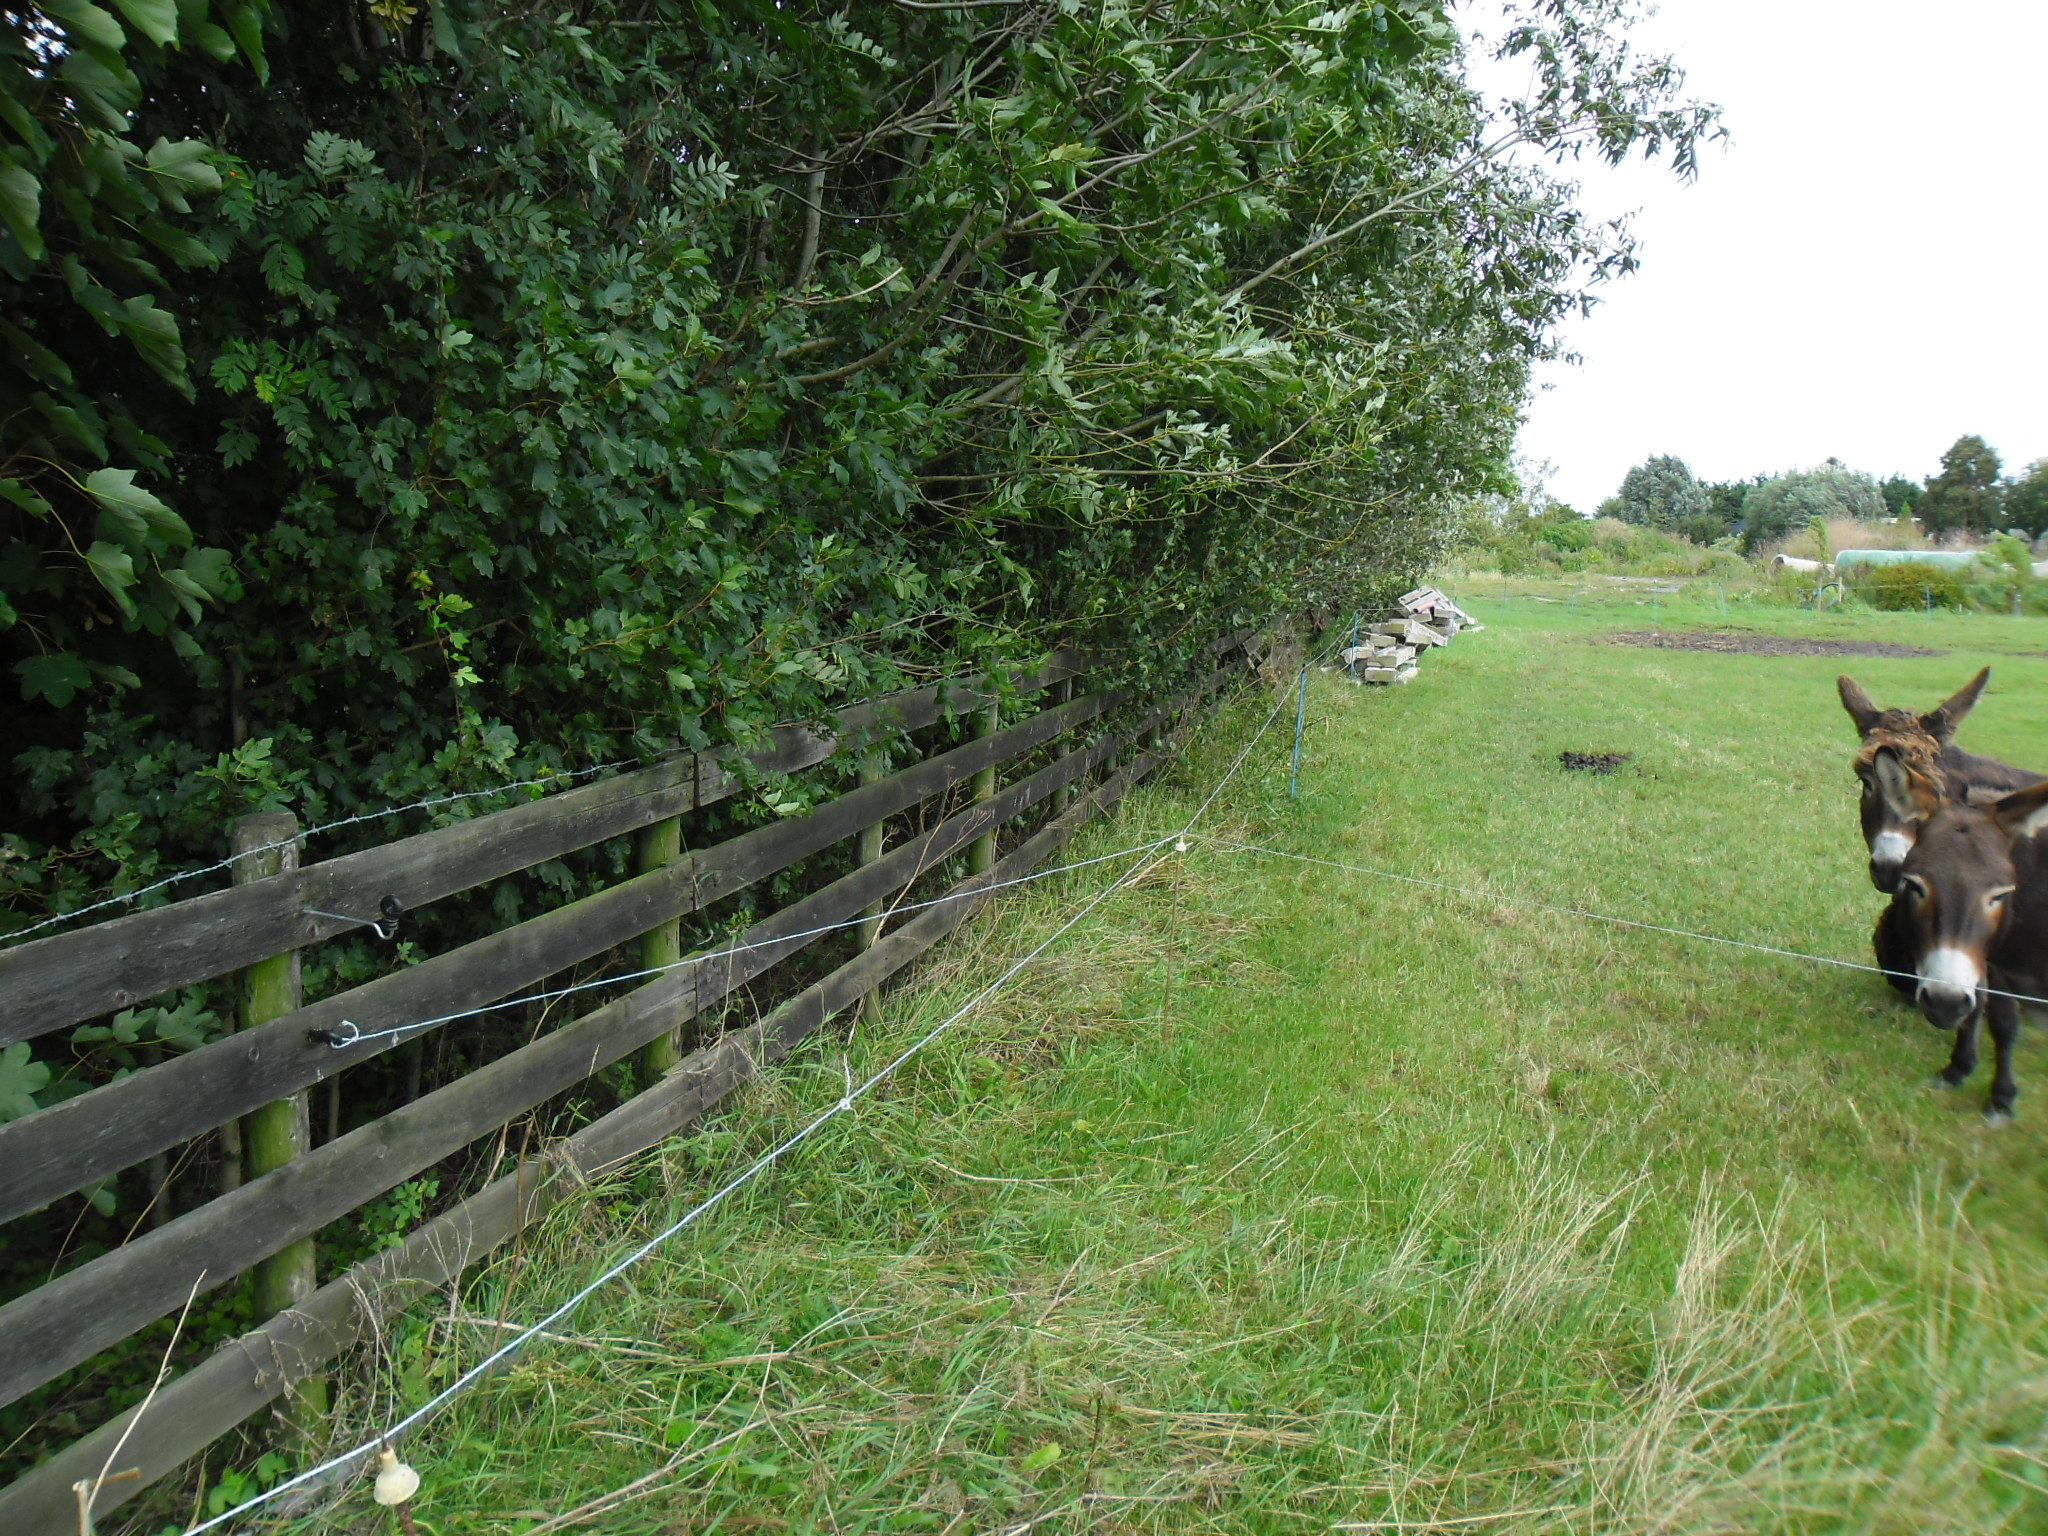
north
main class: Grassland
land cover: Grassland without tree/shrub cover
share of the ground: > 75 %
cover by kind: herbaceous plants 100 %
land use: Agriculture (excluding fallow land and kitchen gardens)
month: August
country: NL
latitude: 53.0509
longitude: 5.5681
